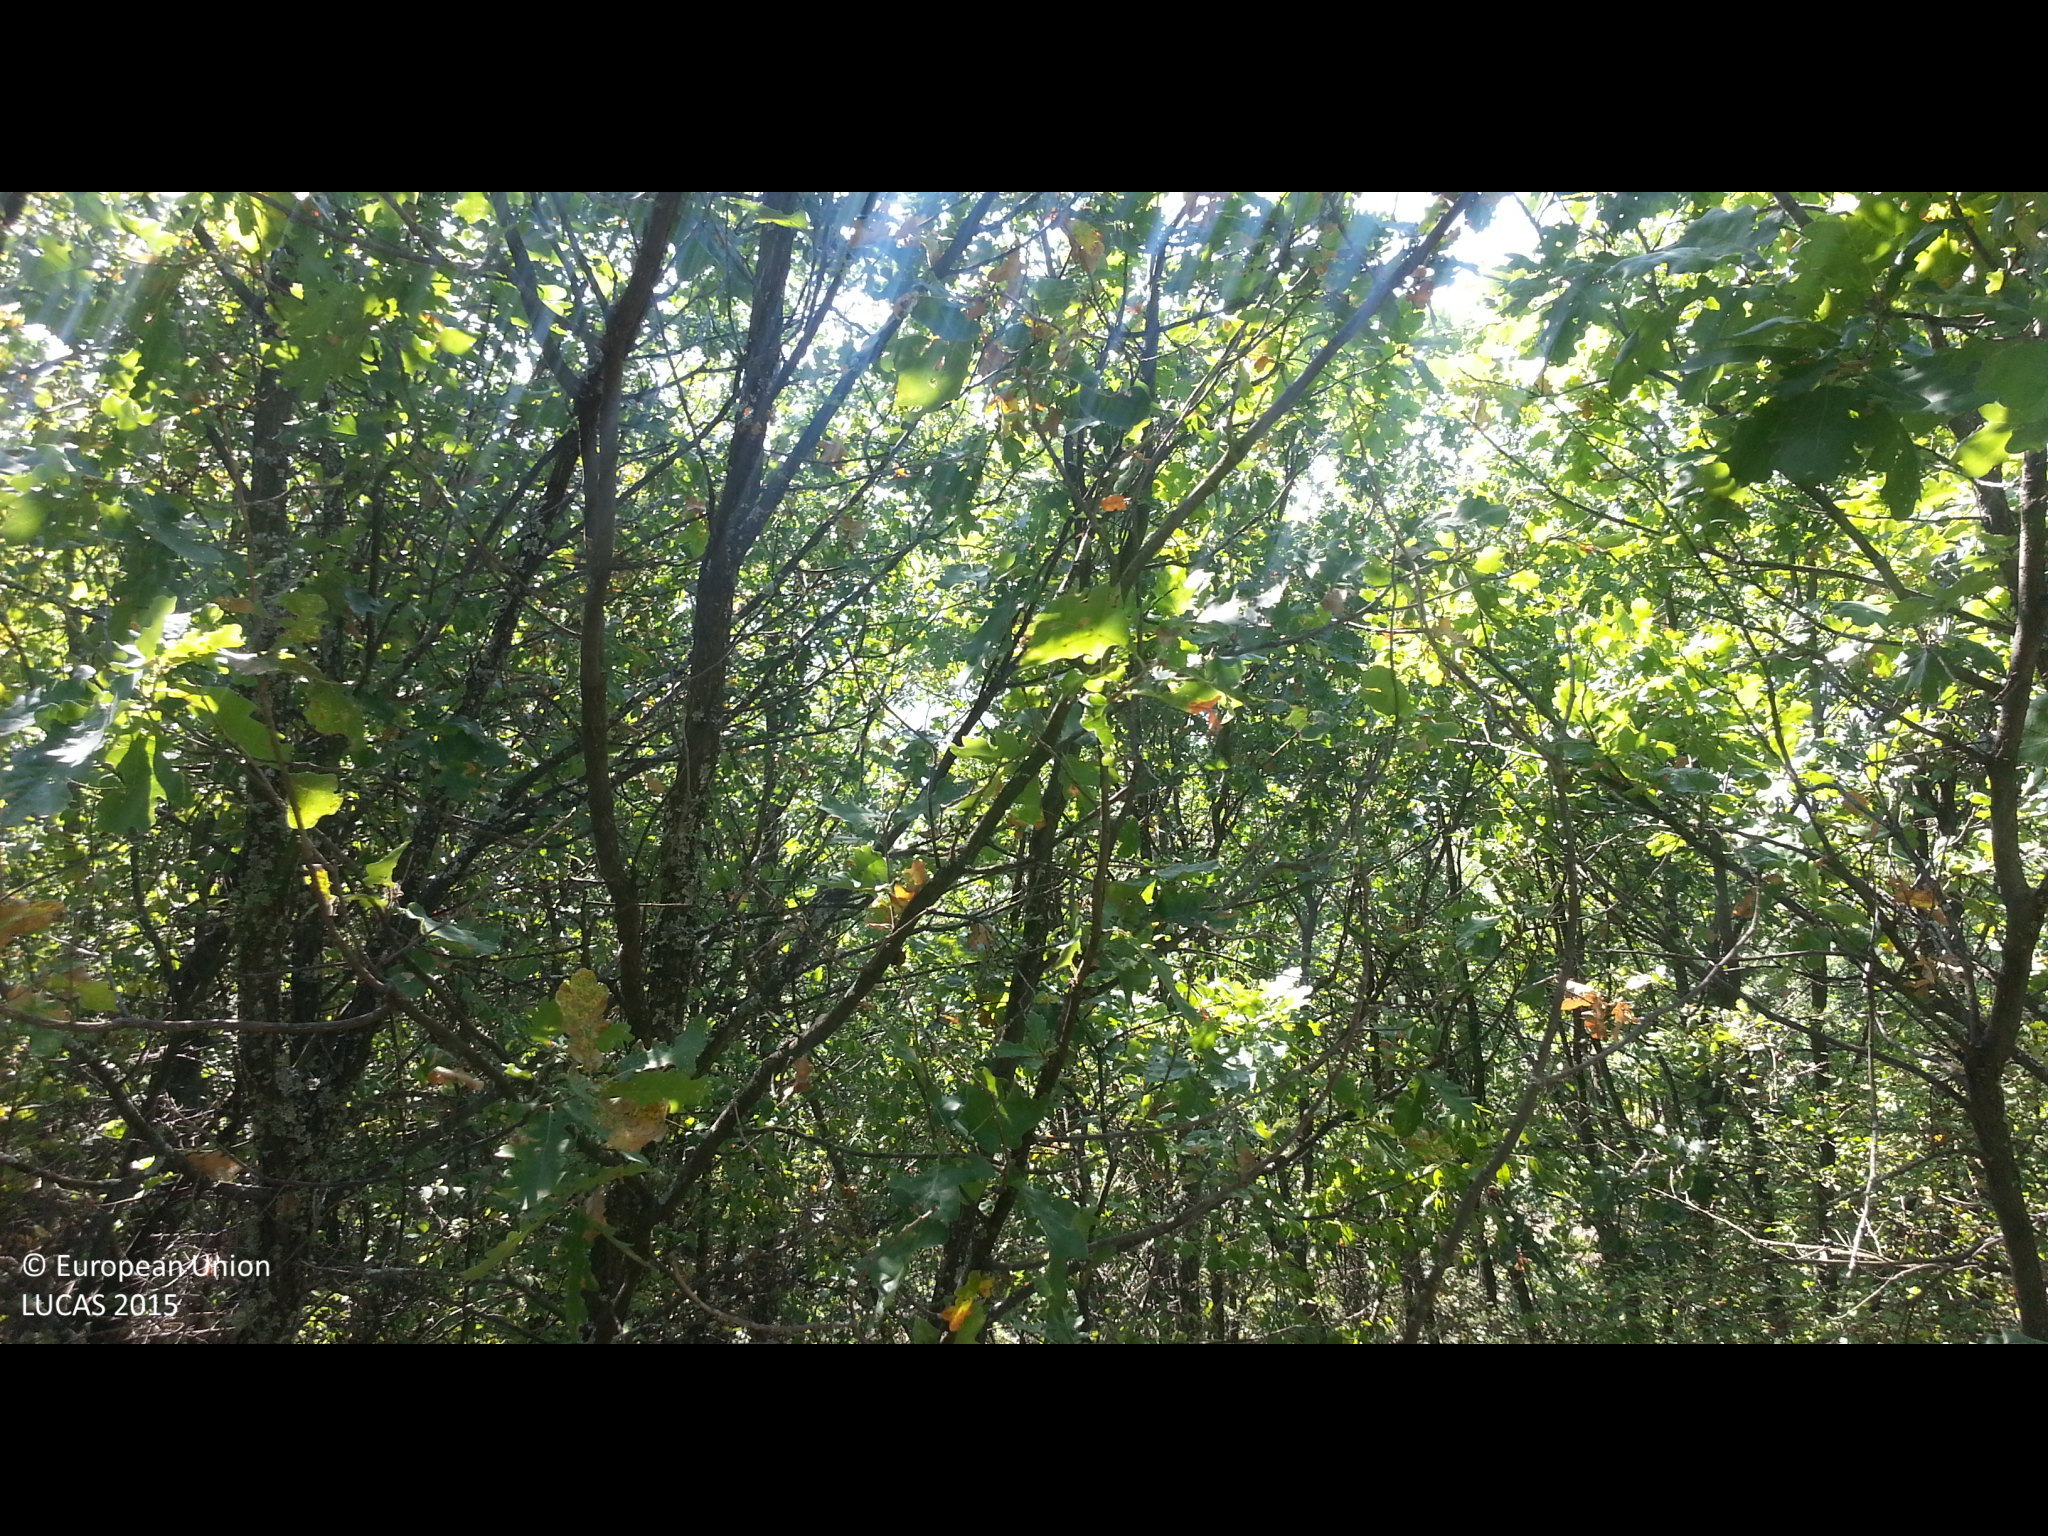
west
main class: Woodland
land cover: Broadleaved woodland
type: thermophilous deciduous forest
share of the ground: > 75 %
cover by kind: broadleaved forest trees 95 %, shrubs 5 %
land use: Forestry
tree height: > 5 m
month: September
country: BG
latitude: 42.1340
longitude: 23.0547
